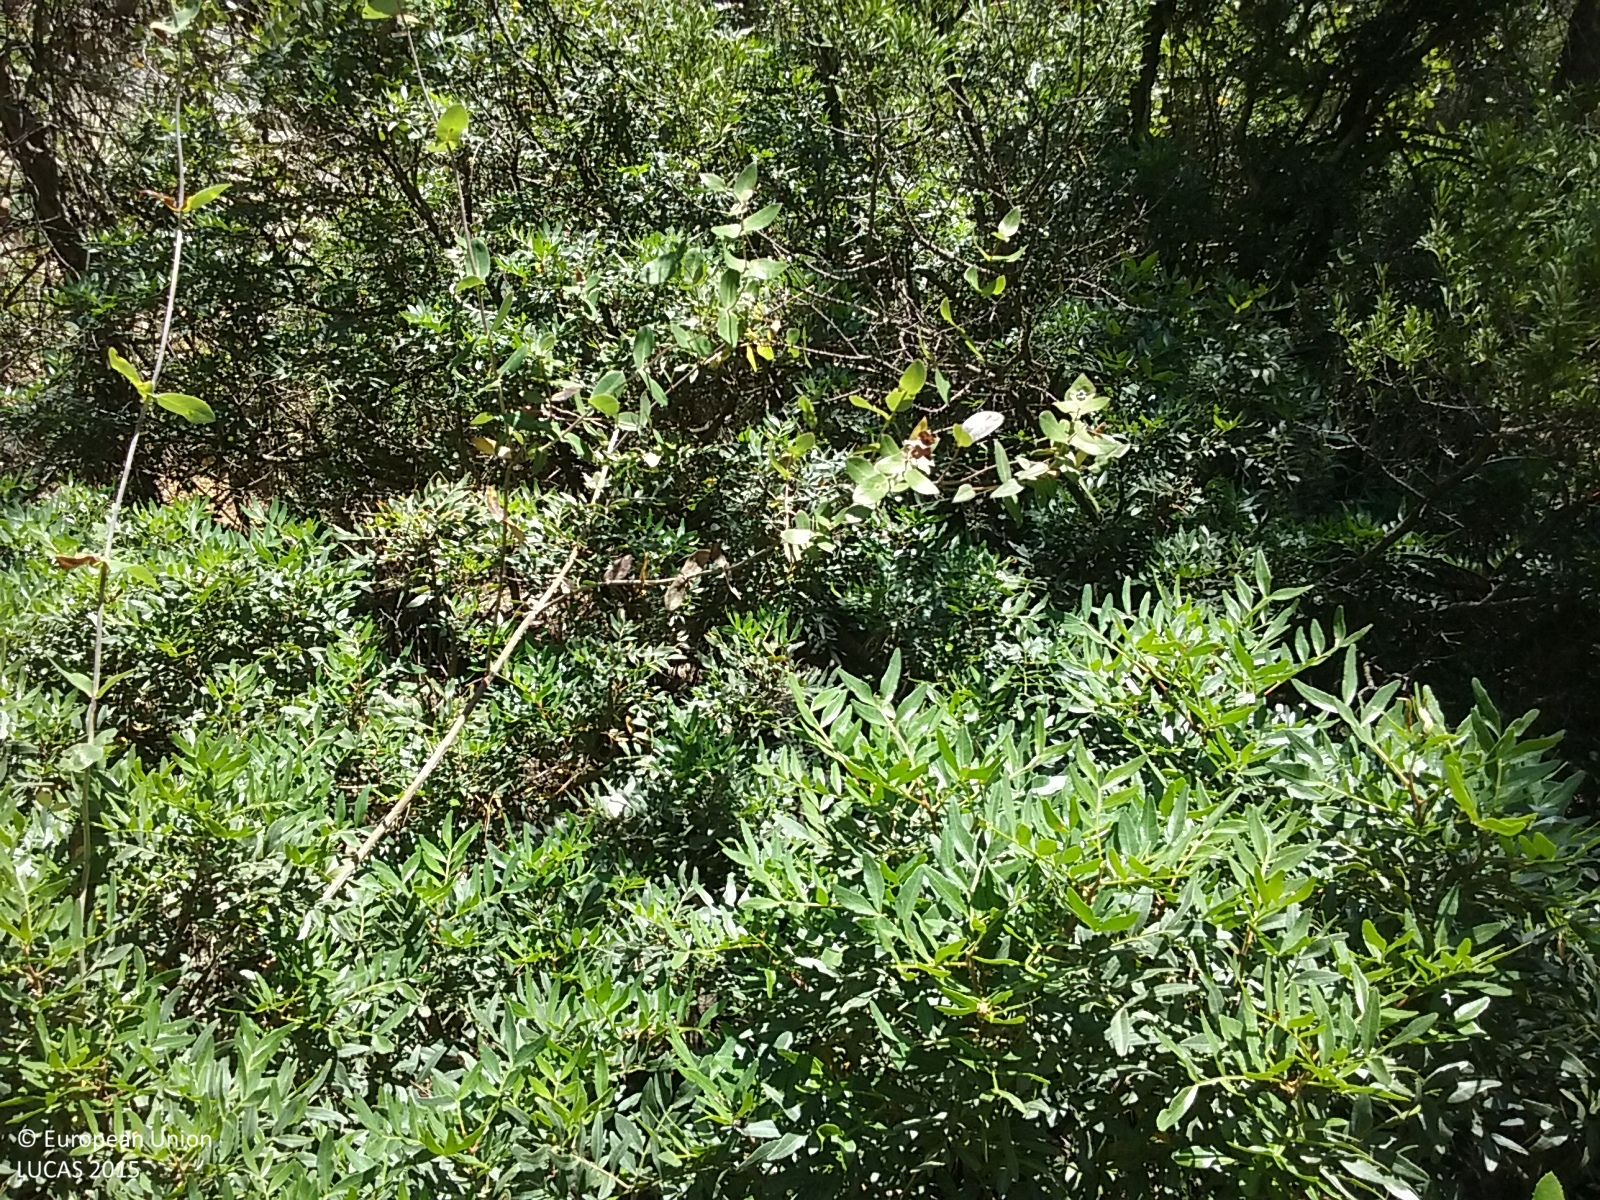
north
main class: Woodland
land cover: Pine dominated coniferous woodland
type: coniferous forest of the mediterranean region
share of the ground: > 75 %
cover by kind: coniferous forest trees 80 %, shrubs 10 %, herbaceous plants 10 %
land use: Semi-natural and natural areas not in use
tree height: > 5 m
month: June
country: ES
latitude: 41.0505
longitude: 0.3899
